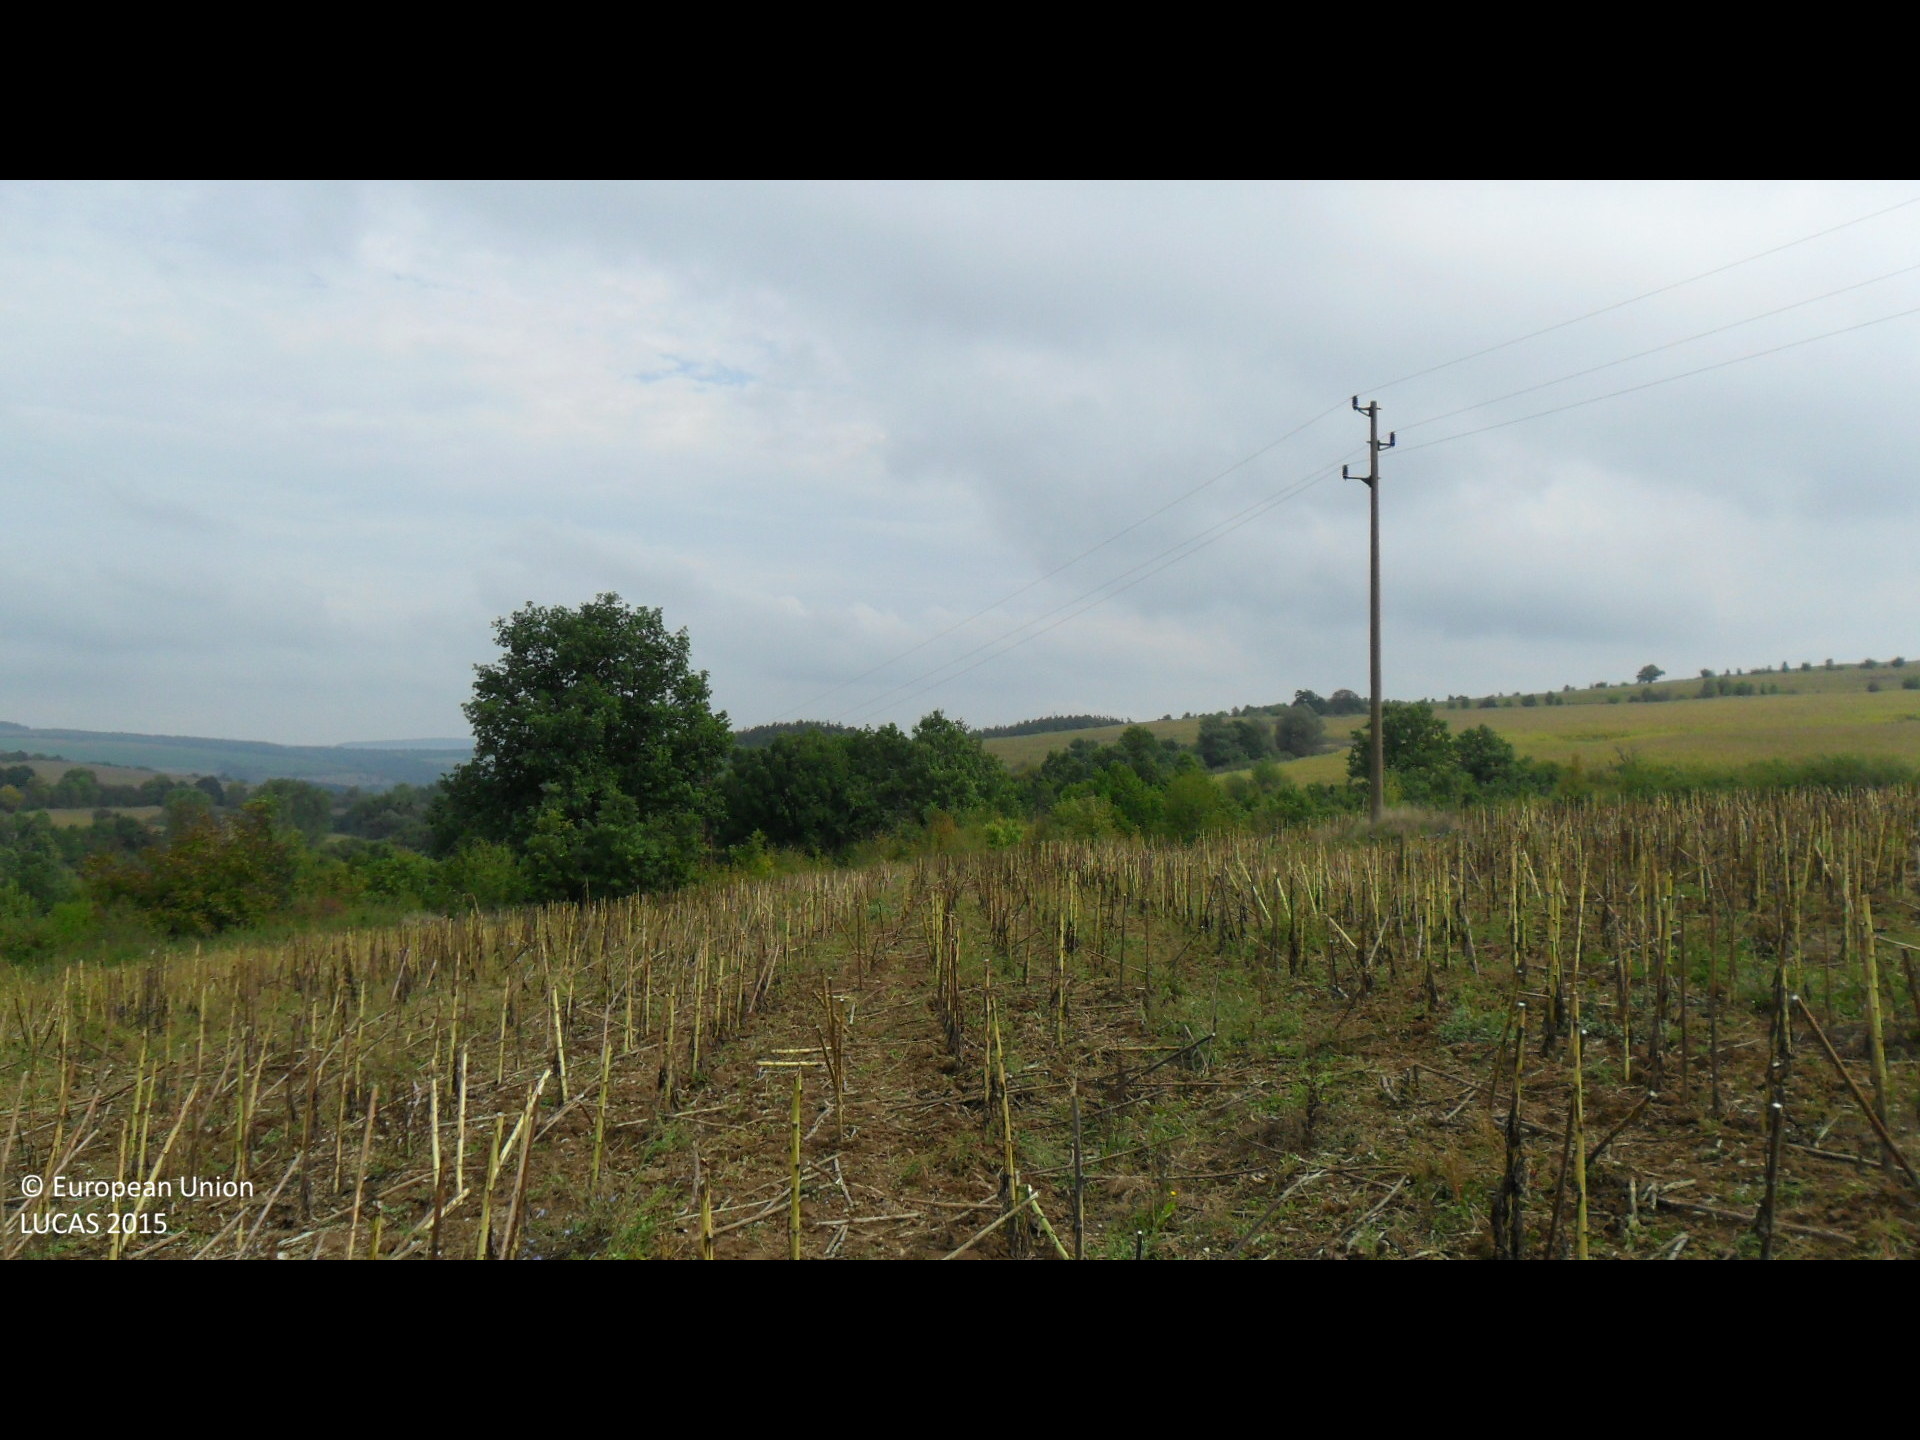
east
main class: Cropland
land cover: Sunflower
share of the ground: 50 - 75 %
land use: Agriculture (excluding fallow land and kitchen gardens)
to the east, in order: Sunflower; Electric lines; Sunflower; Shrubland with sparse tree cover; Broadleaved woodland; Grassland with sparse tree/shrub cover; Broadleaved woodland
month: September
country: BG
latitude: 43.0668
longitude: 26.3170
